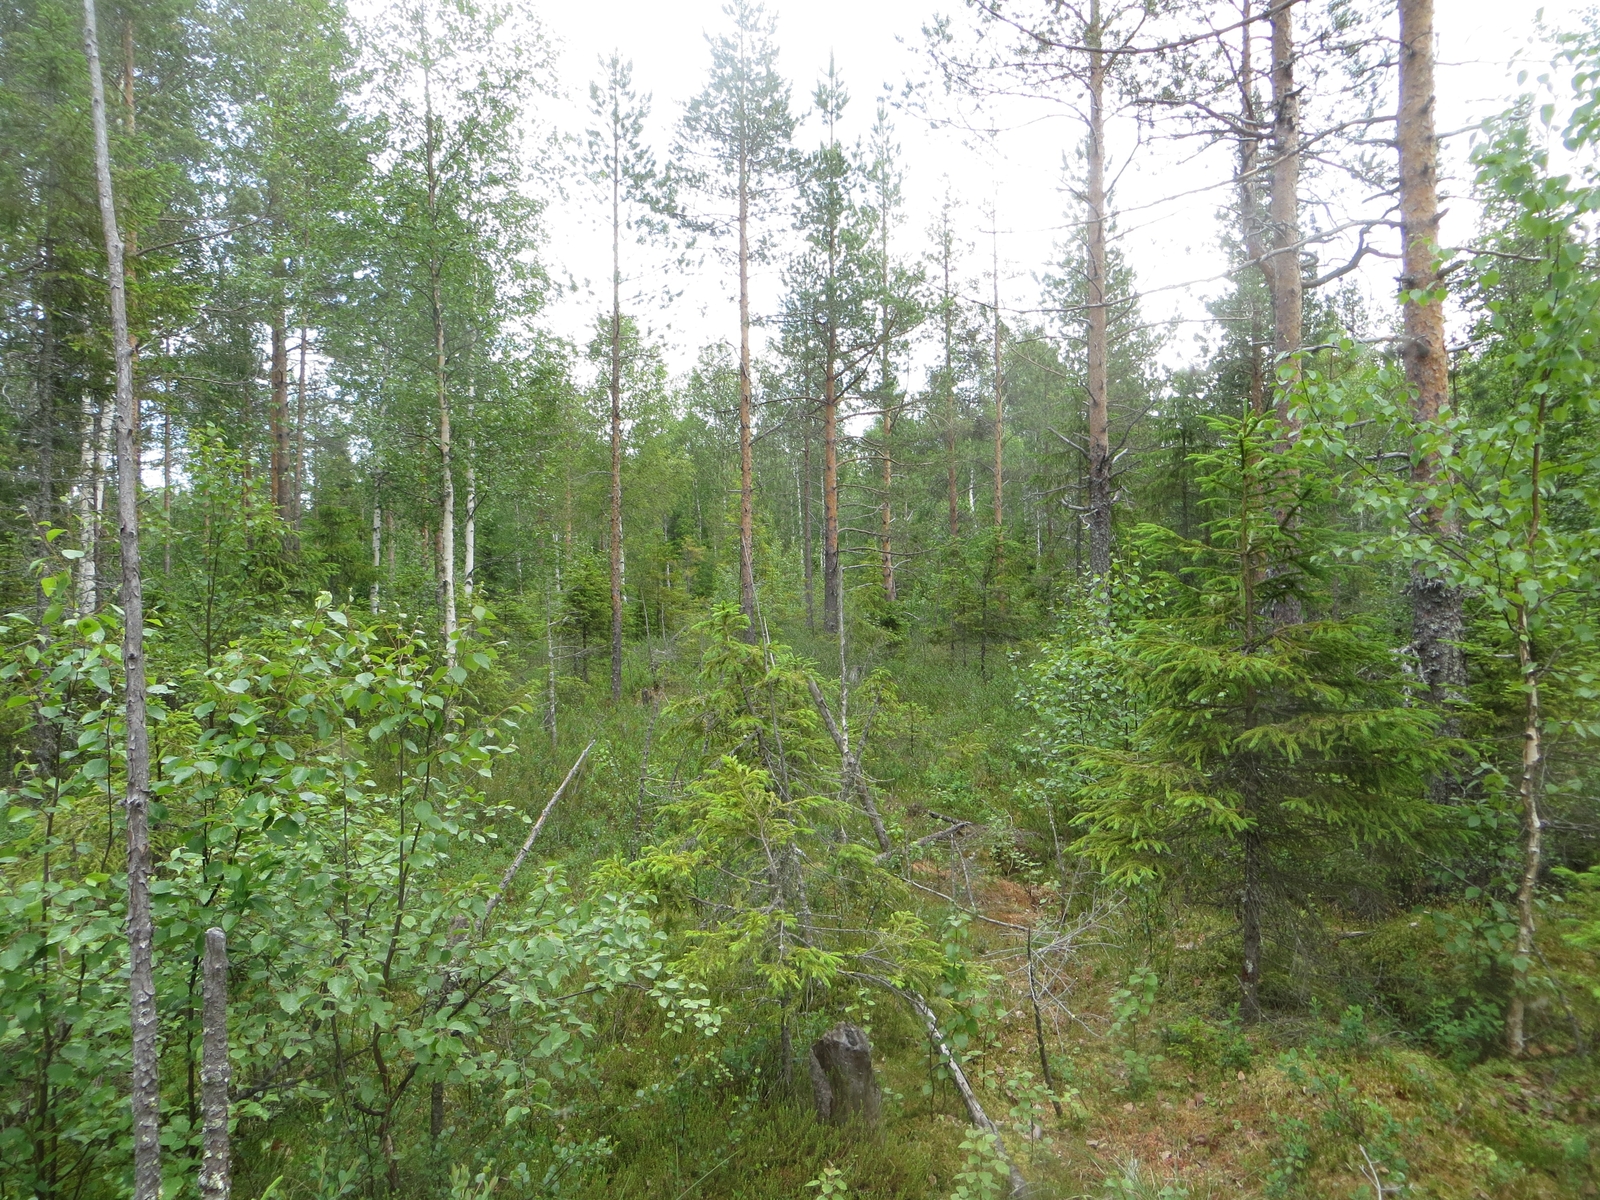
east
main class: Woodland
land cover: Pine dominated mixed woodland
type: boreal forest
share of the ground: 50 - 75 %
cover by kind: coniferous forest trees 40 %, shrubs 40 %, broadleaved forest trees 20 %
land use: Forestry
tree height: > 5 m
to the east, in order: Pine dominated mixed woodland; Ditches and canals; Pine dominated mixed woodland; Spruce dominated mixed woodland; Ditches and canals; Spruce dominated mixed woodland; Ditches and canals; Spruce dominated mixed woodland; Ditches and canals; Broadleaved woodland; Ditches and canals; Broadleaved woodland
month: July
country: FI
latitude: 65.4633
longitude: 25.8618
